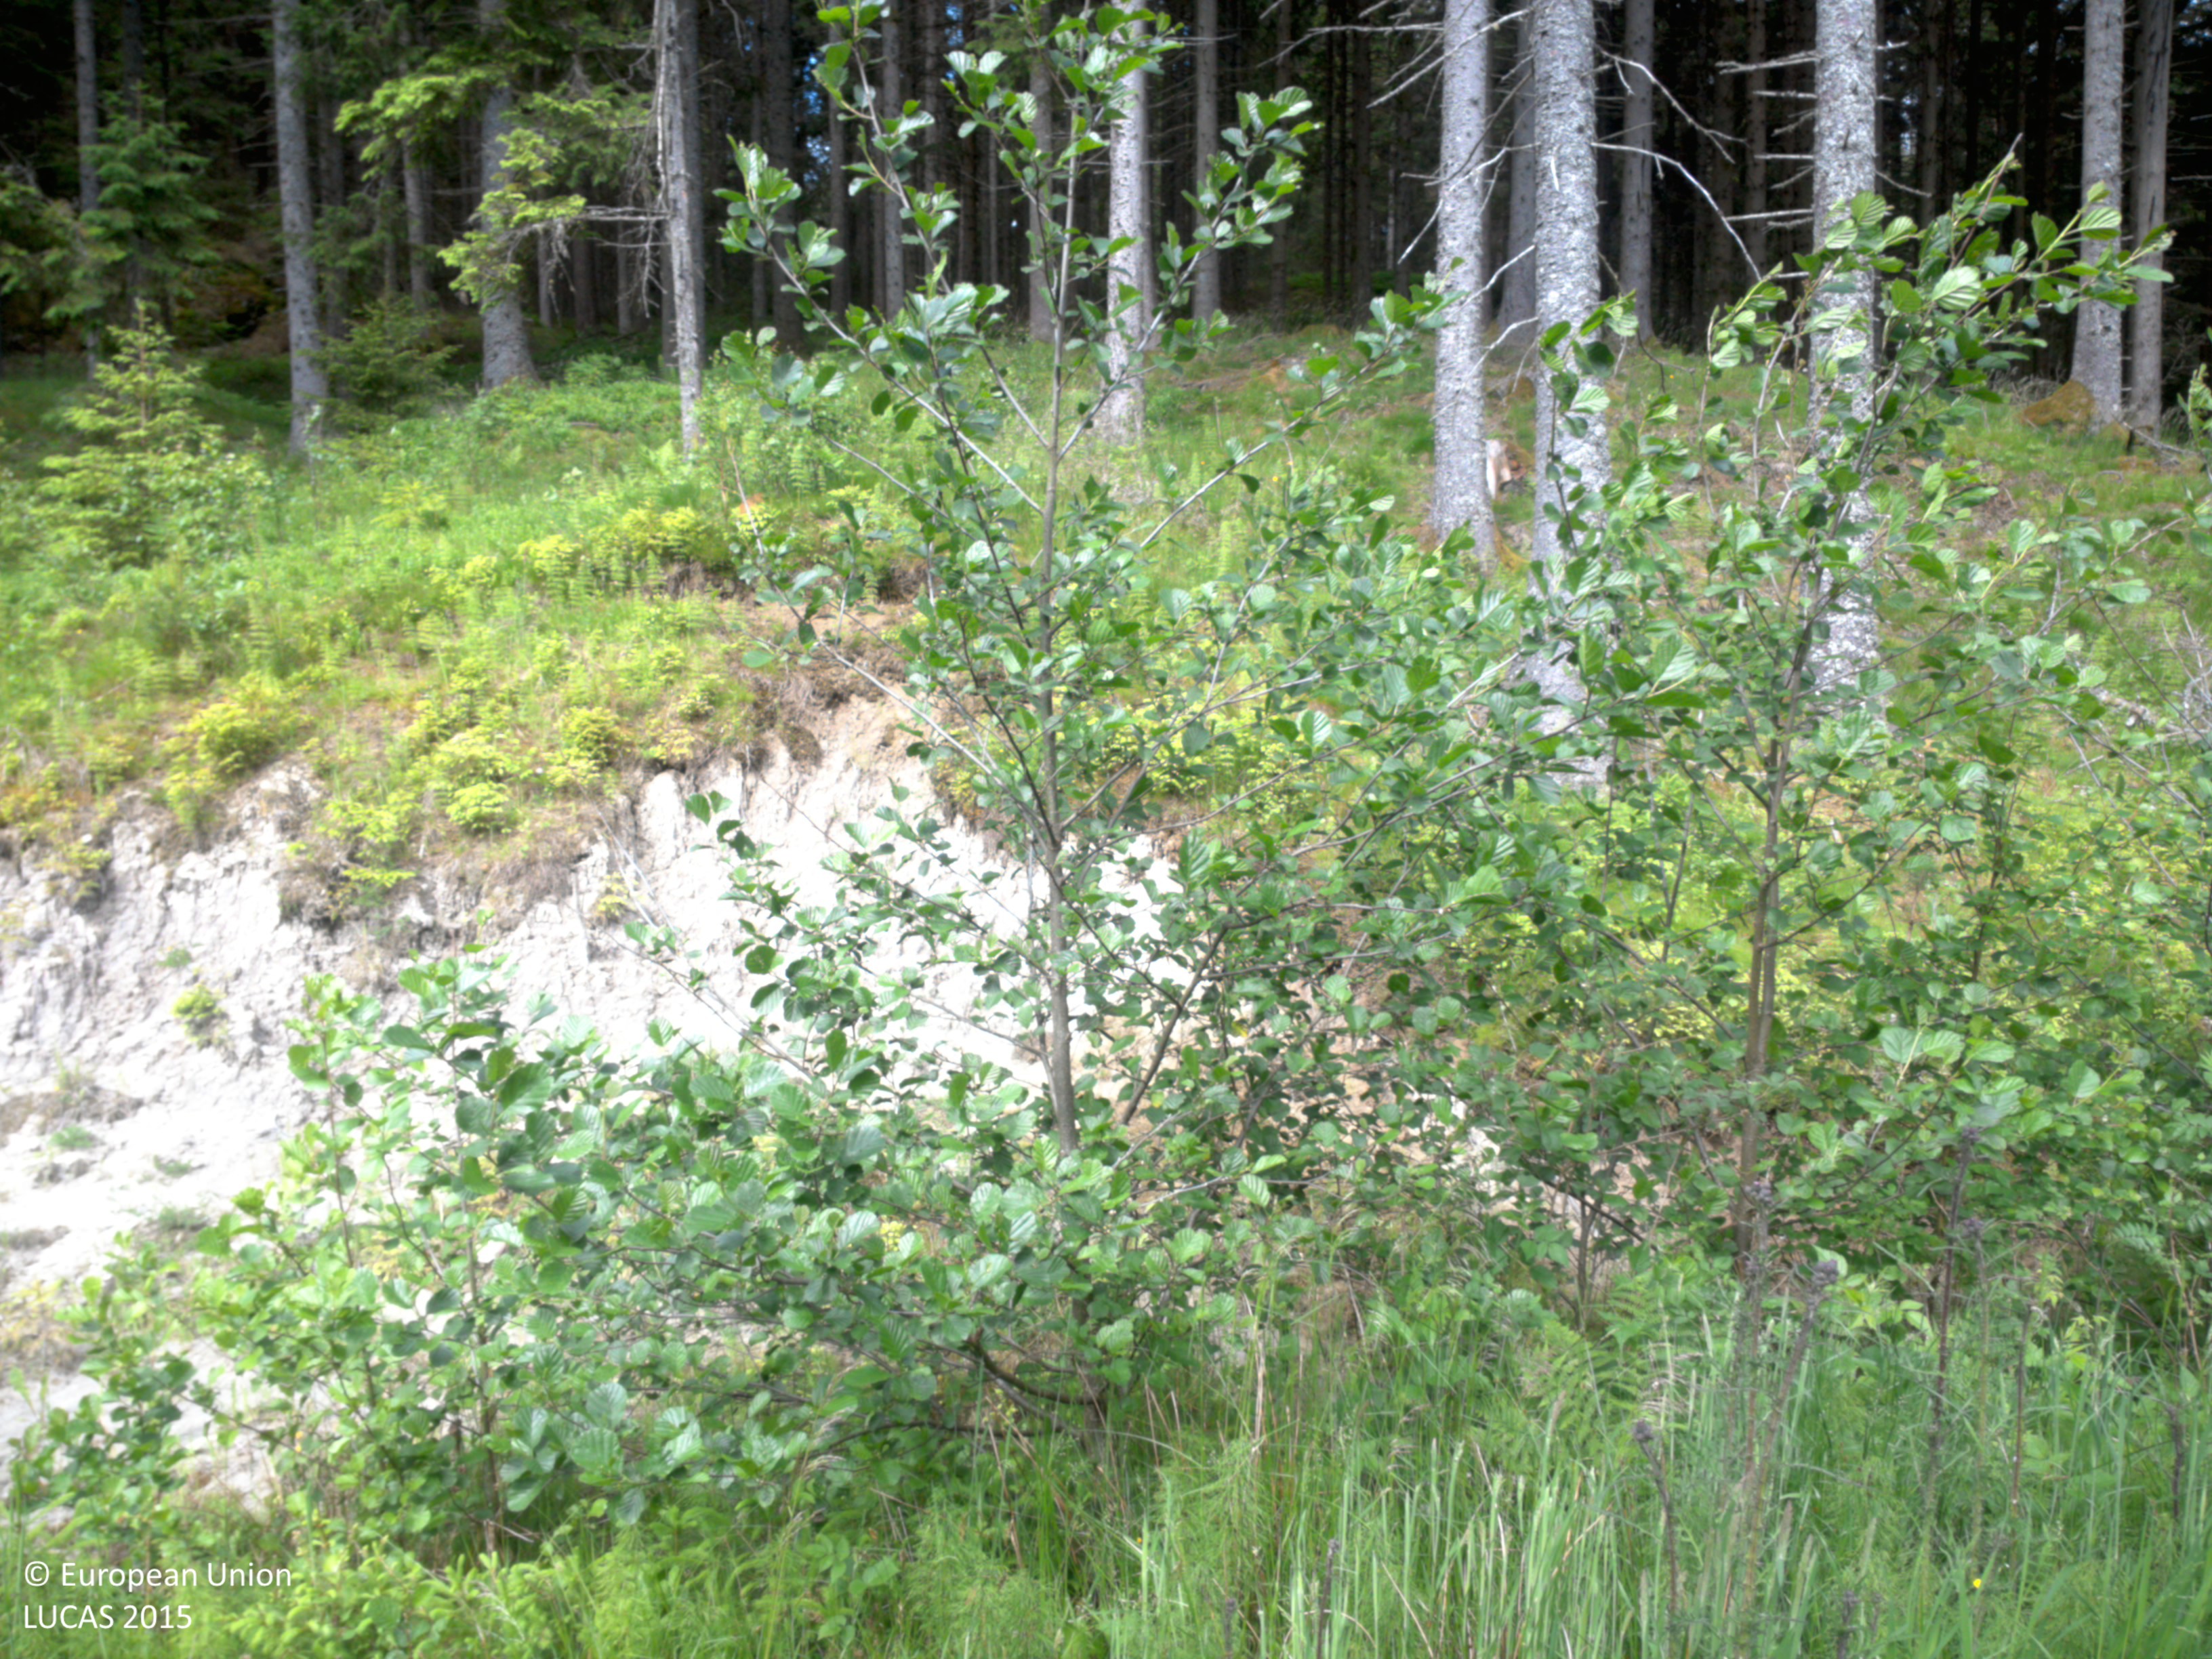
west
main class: Grassland
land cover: Grassland without tree/shrub cover
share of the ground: > 75 %
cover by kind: herbaceous plants 100 %
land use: Abandoned areas
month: June
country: SE
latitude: 58.6965
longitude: 11.5323
